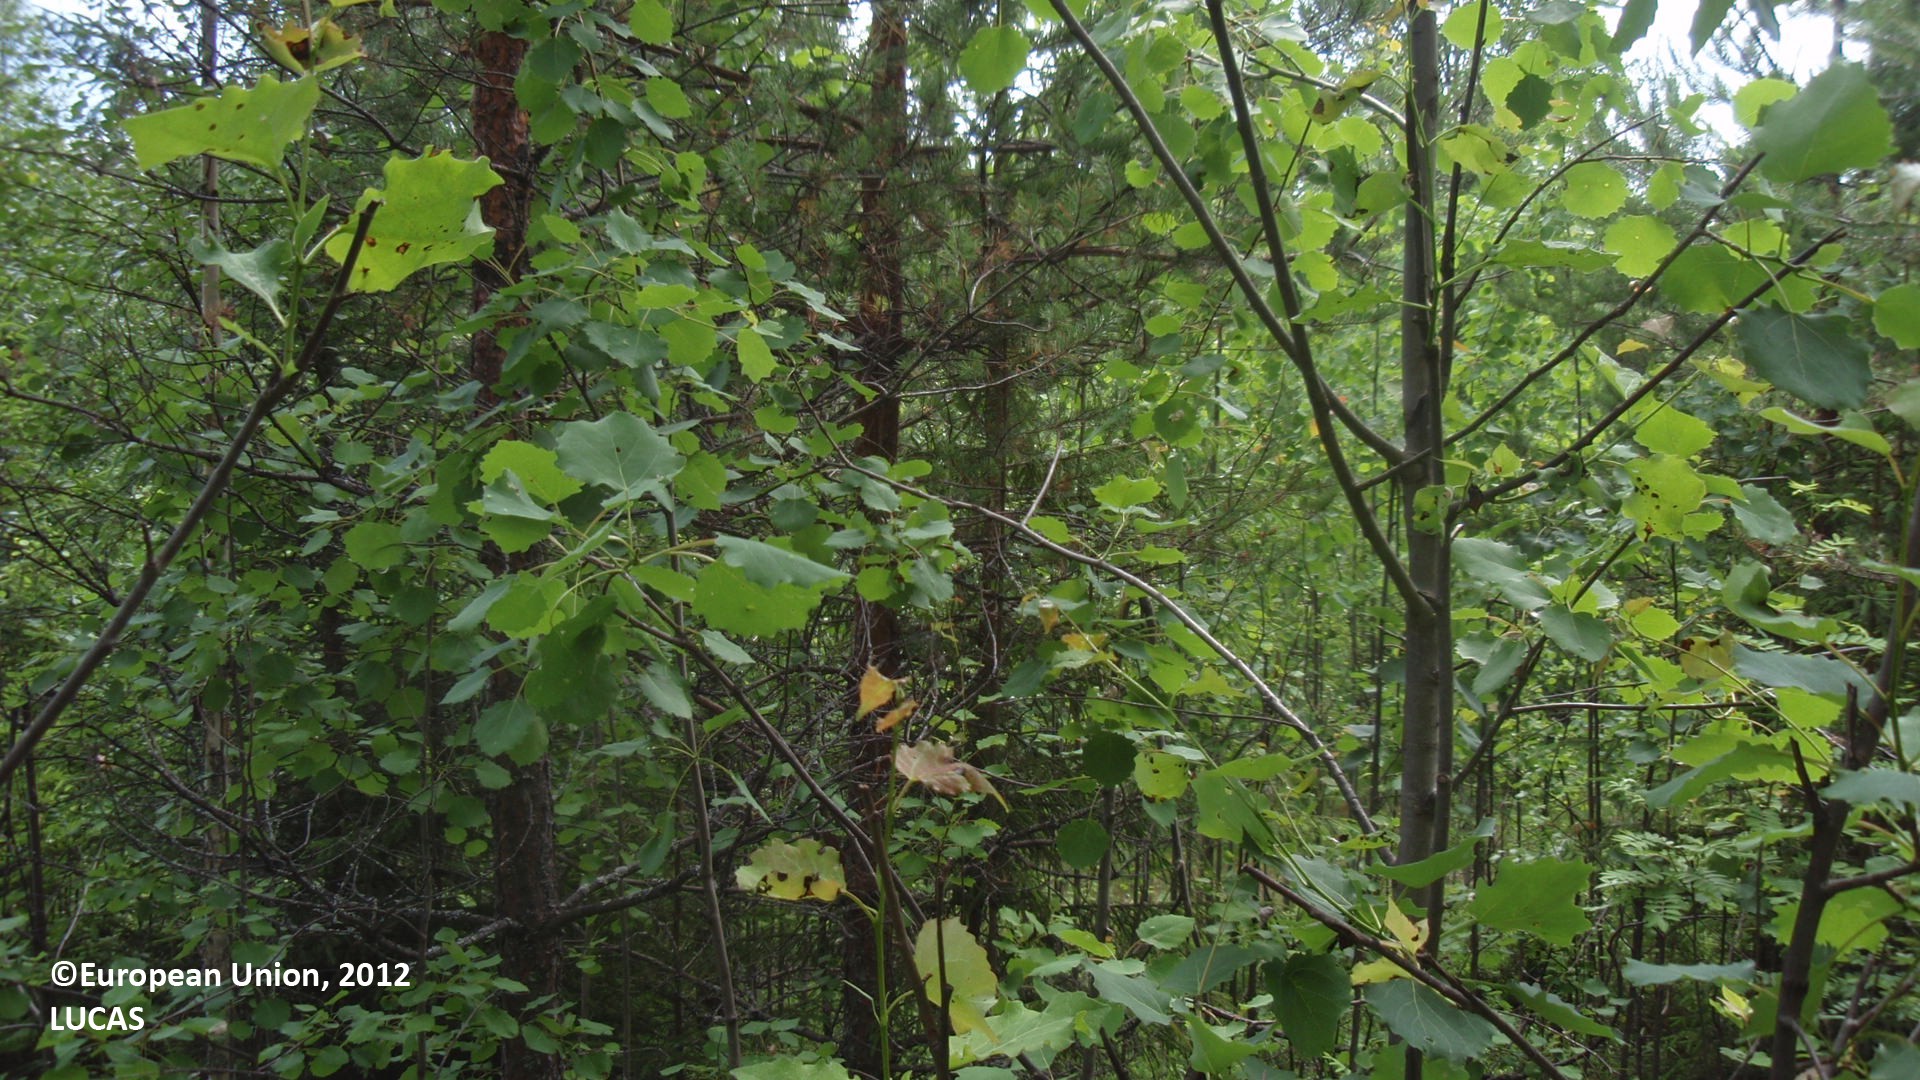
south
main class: Woodland
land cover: Spruce dominated mixed woodland
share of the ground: 25 - 50 %
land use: Forestry
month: July
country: FI
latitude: 61.7039
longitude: 28.1040
